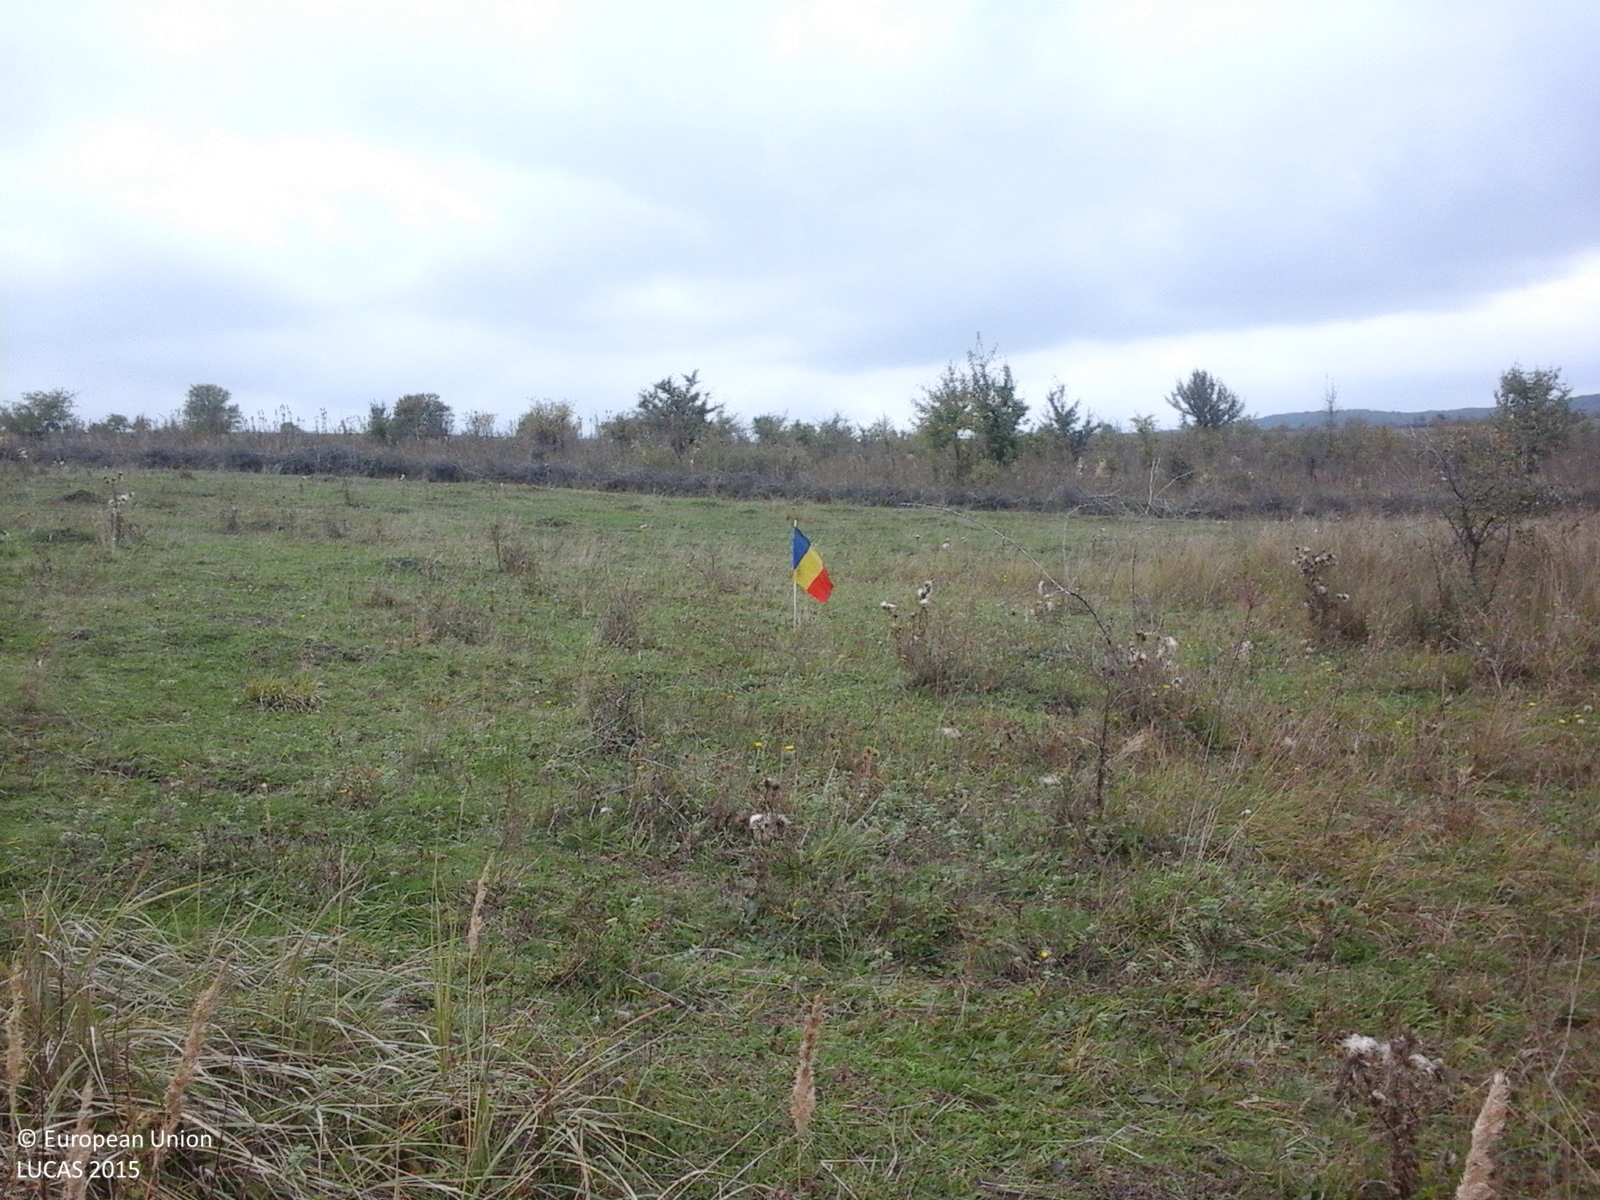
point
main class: Grassland
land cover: Grassland with sparse tree/shrub cover
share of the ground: > 75 %
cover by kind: herbaceous plants 85 %, shrubs 10 %, broadleaved forest trees 5 %
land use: Fallow land
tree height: < 5 m
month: October
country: RO
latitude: 46.0547
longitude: 25.1289
